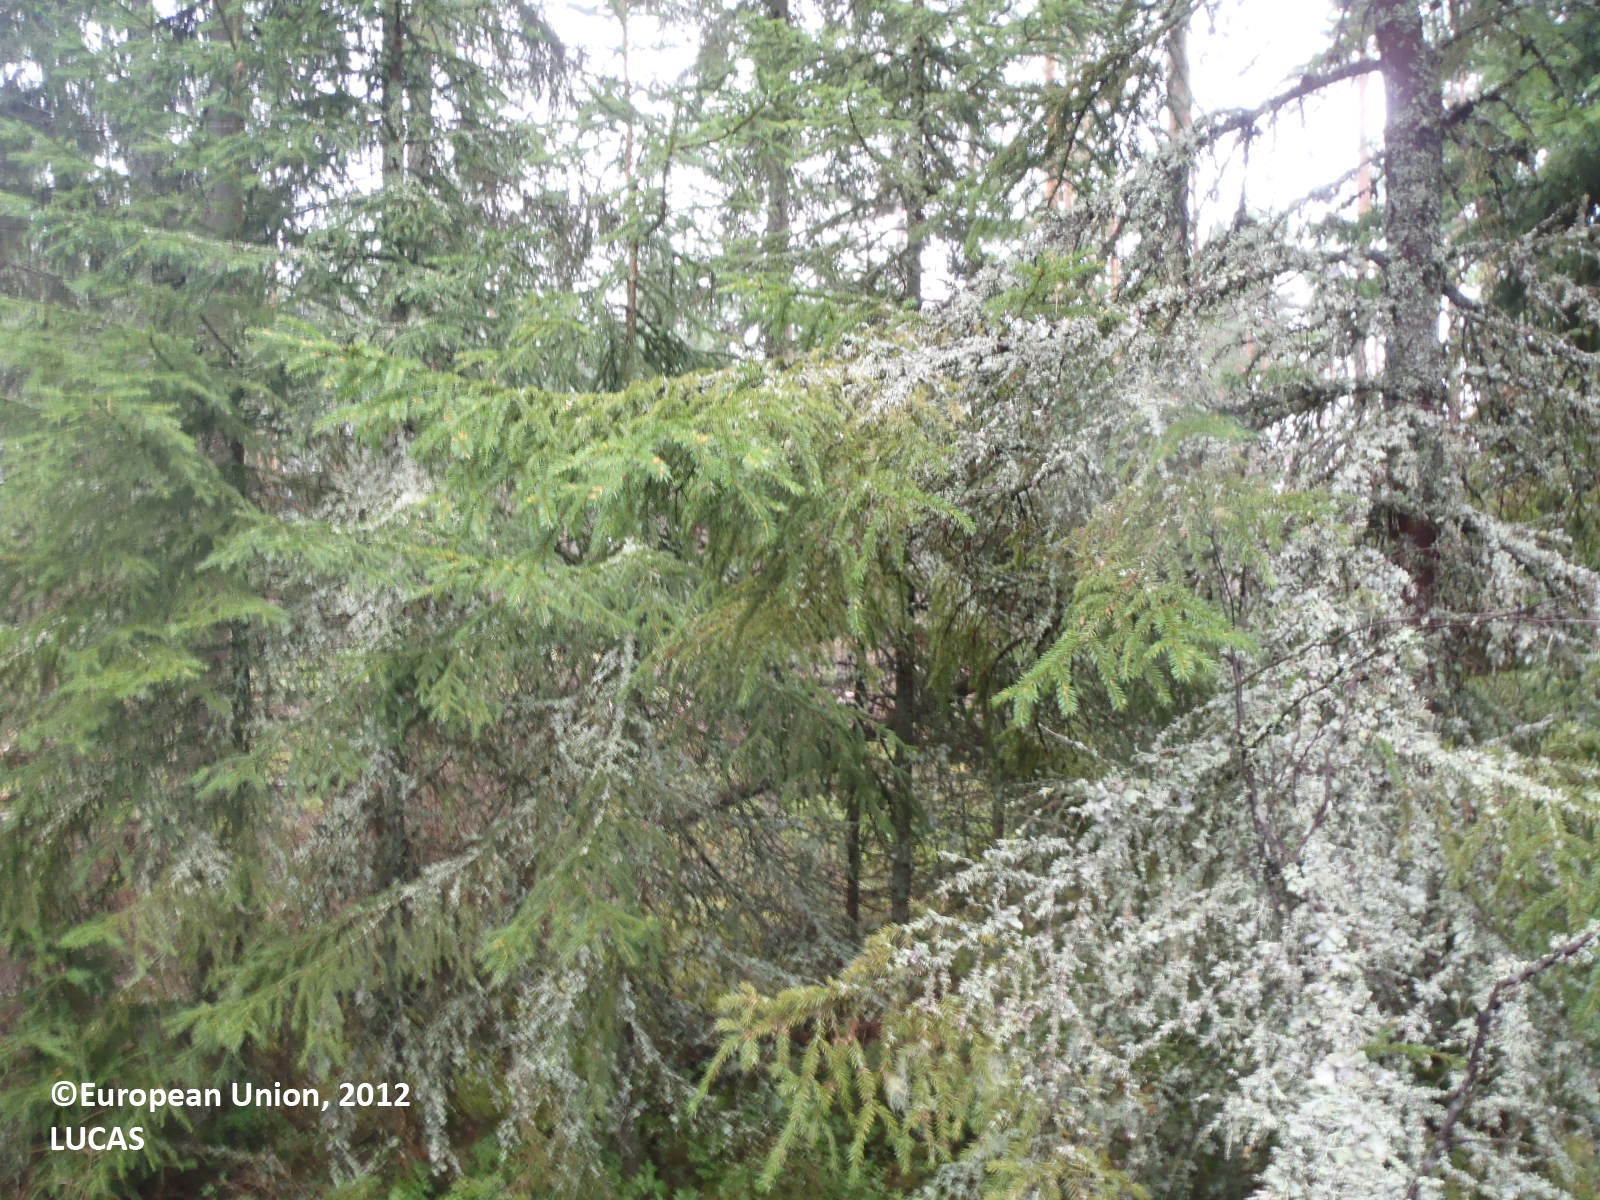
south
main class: Woodland
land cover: Spruce dominated mixed woodland
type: boreal forest
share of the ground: > 75 %
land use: Forestry
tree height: > 5 m
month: July
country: FI
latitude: 60.7457
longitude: 21.7437
